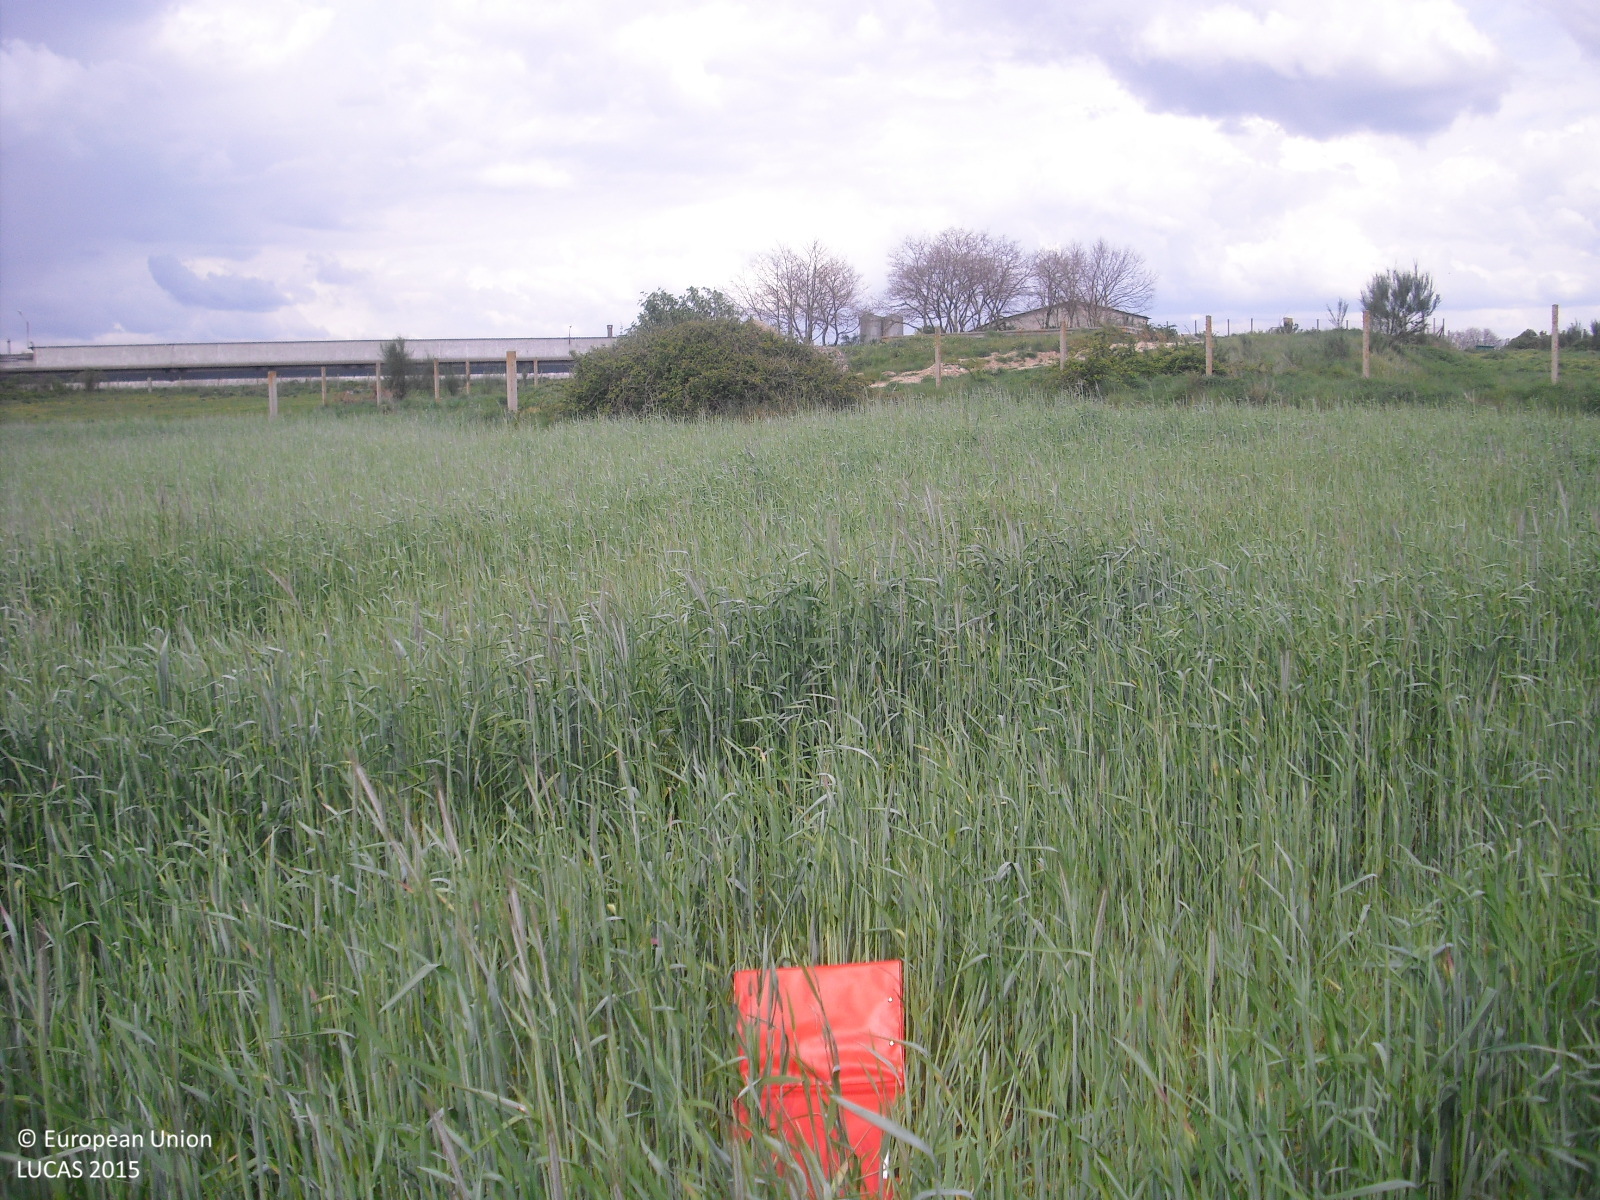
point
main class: Cropland
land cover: Rye
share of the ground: > 75 %
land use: Agriculture (excluding fallow land and kitchen gardens)
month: April
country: ES
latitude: 41.9973
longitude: -7.7304
